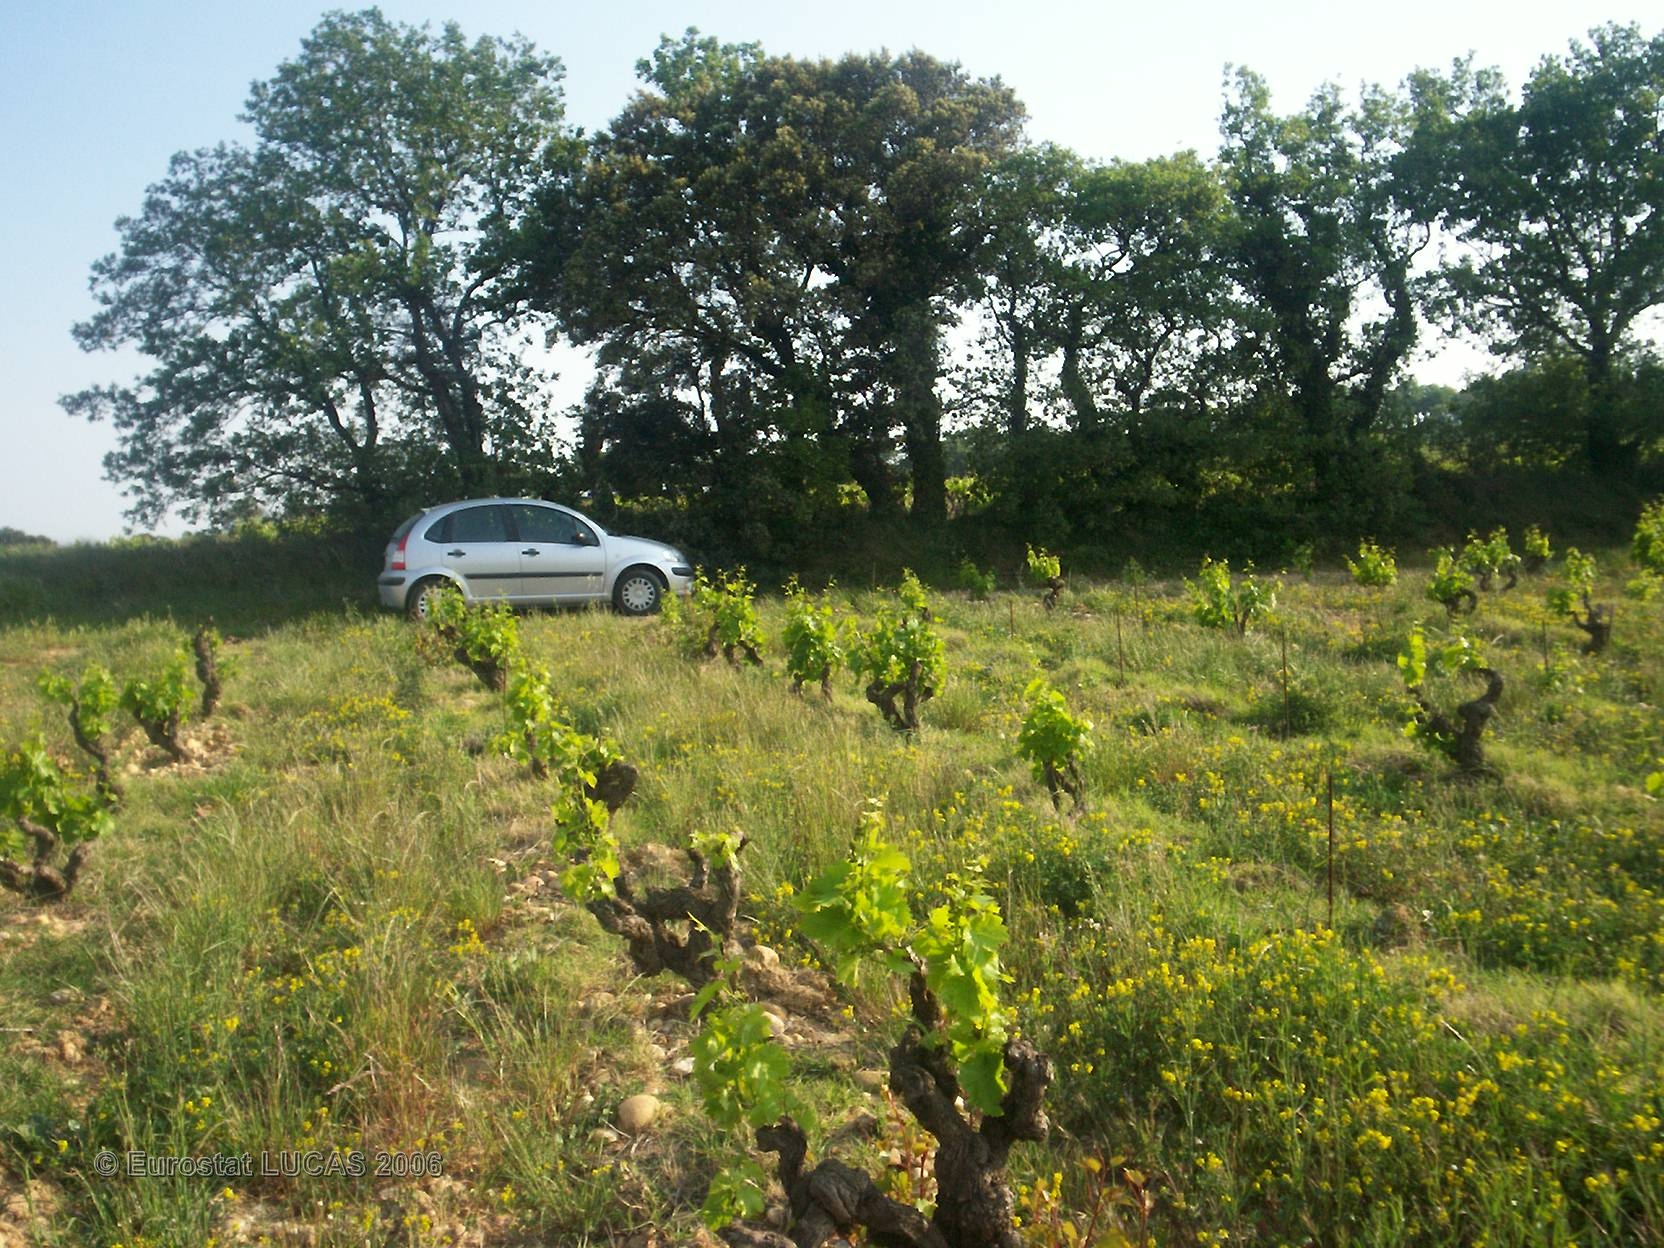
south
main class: Cropland
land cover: Vineyards
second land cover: Grassland without tree/shrub cover
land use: Agriculture (excluding fallow land and kitchen gardens)
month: May
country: FR
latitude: 44.0614
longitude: 4.8774
